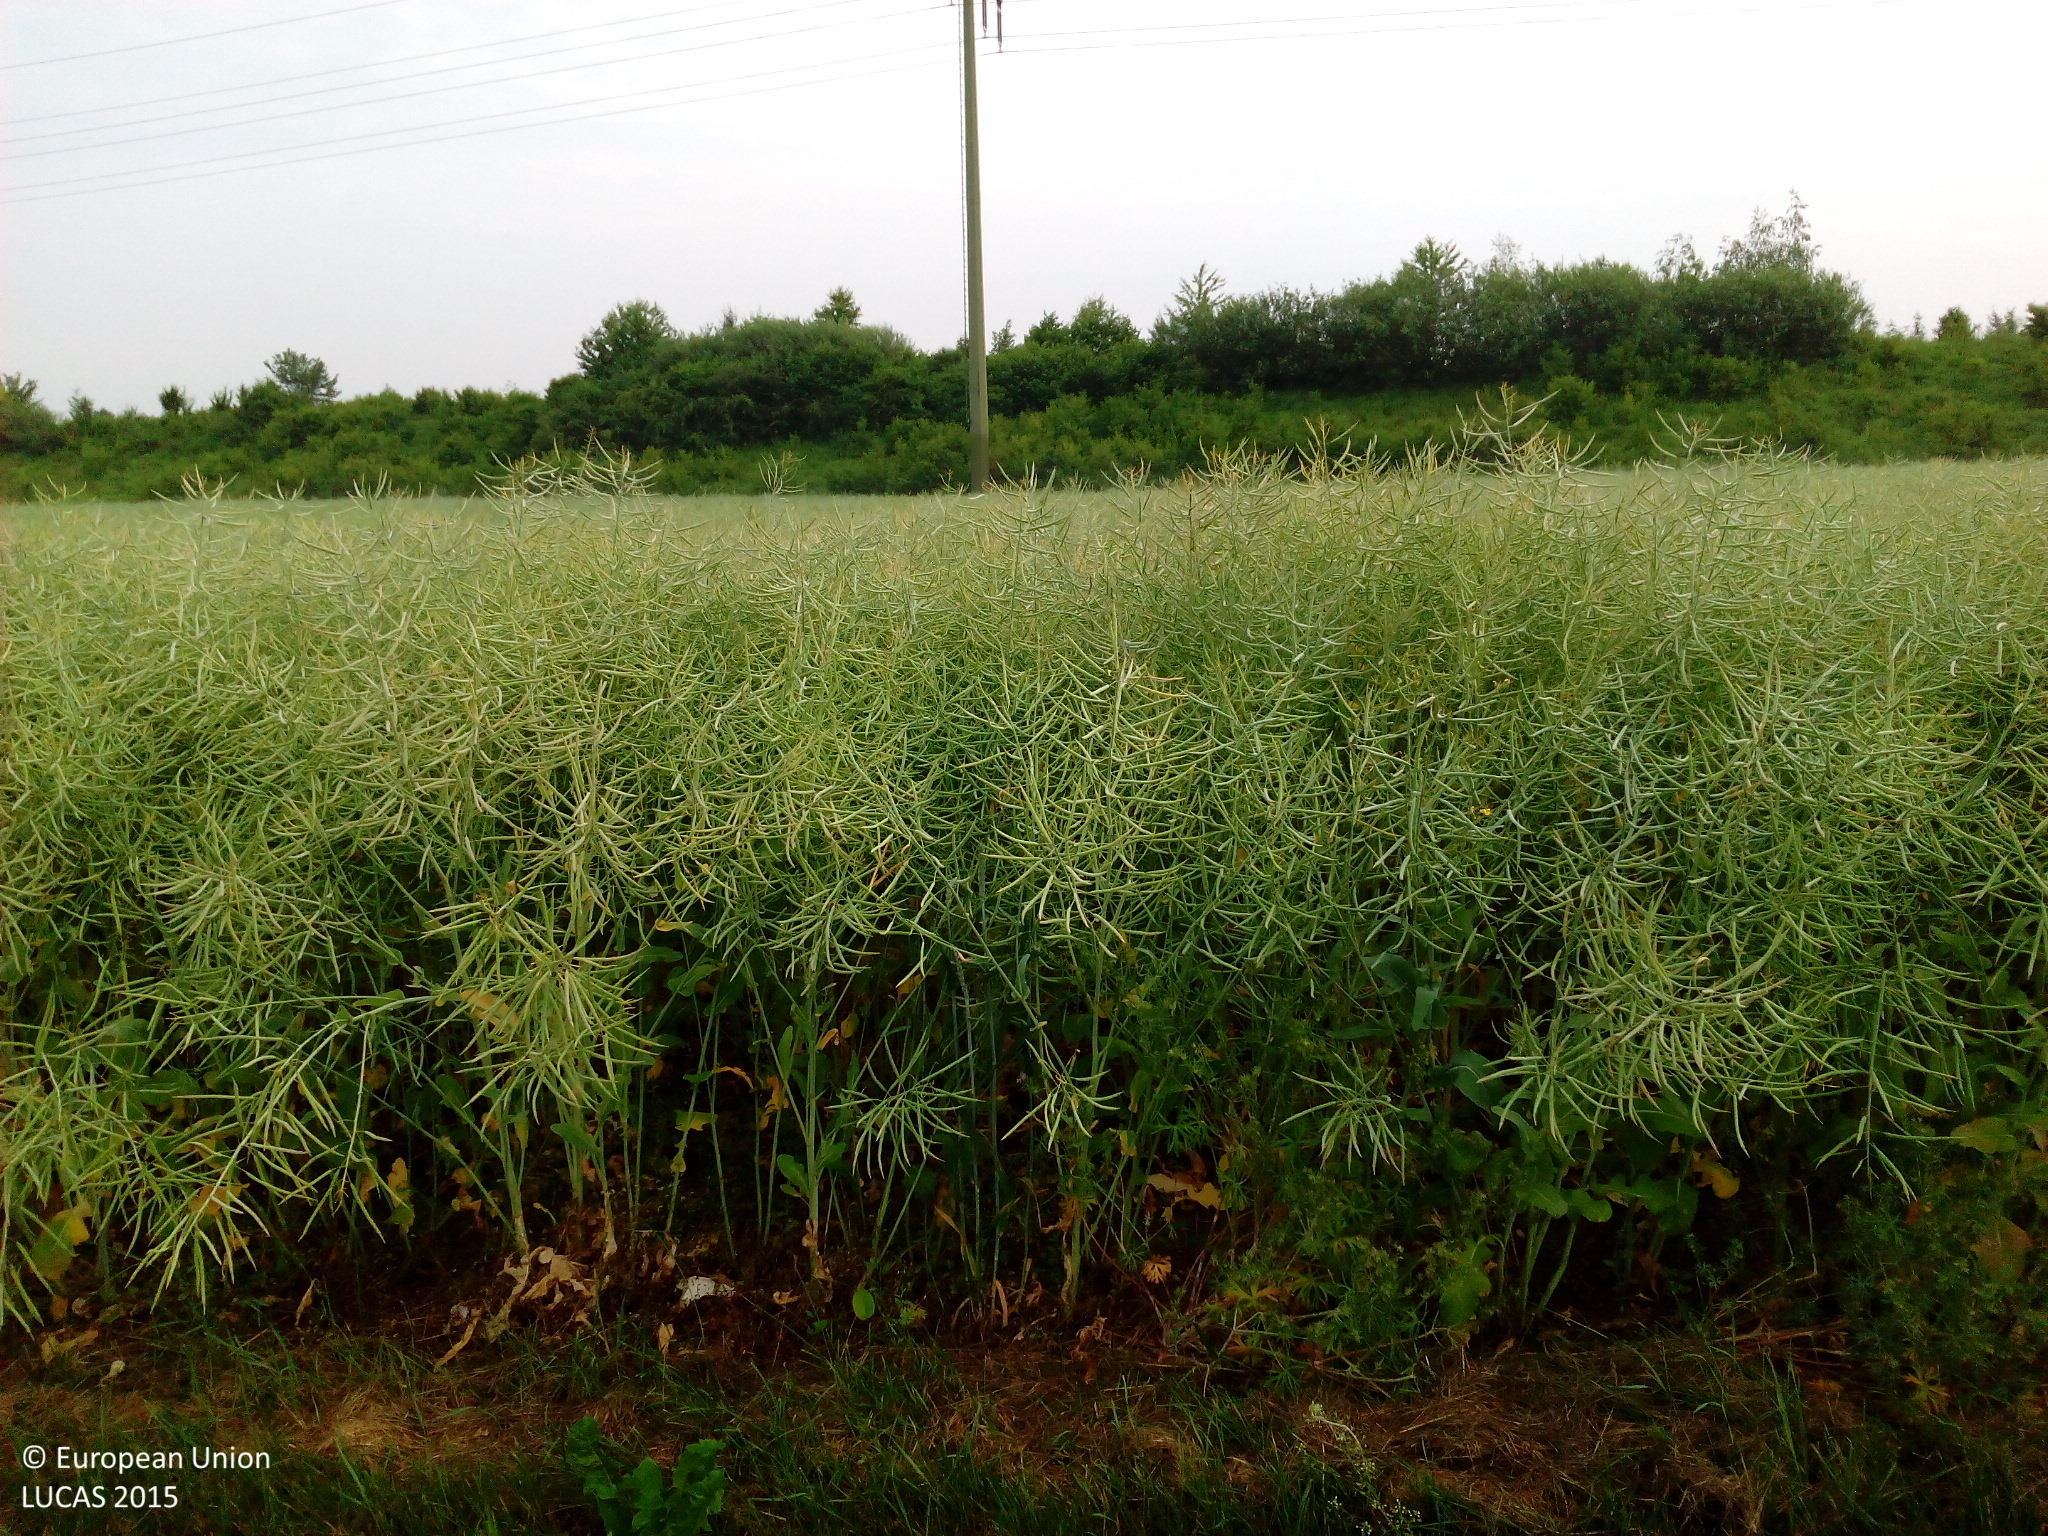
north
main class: Cropland
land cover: Rape and turnip rape
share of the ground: > 75 %
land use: Agriculture (excluding fallow land and kitchen gardens)
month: June
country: DE
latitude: 48.6909
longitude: 9.6877
